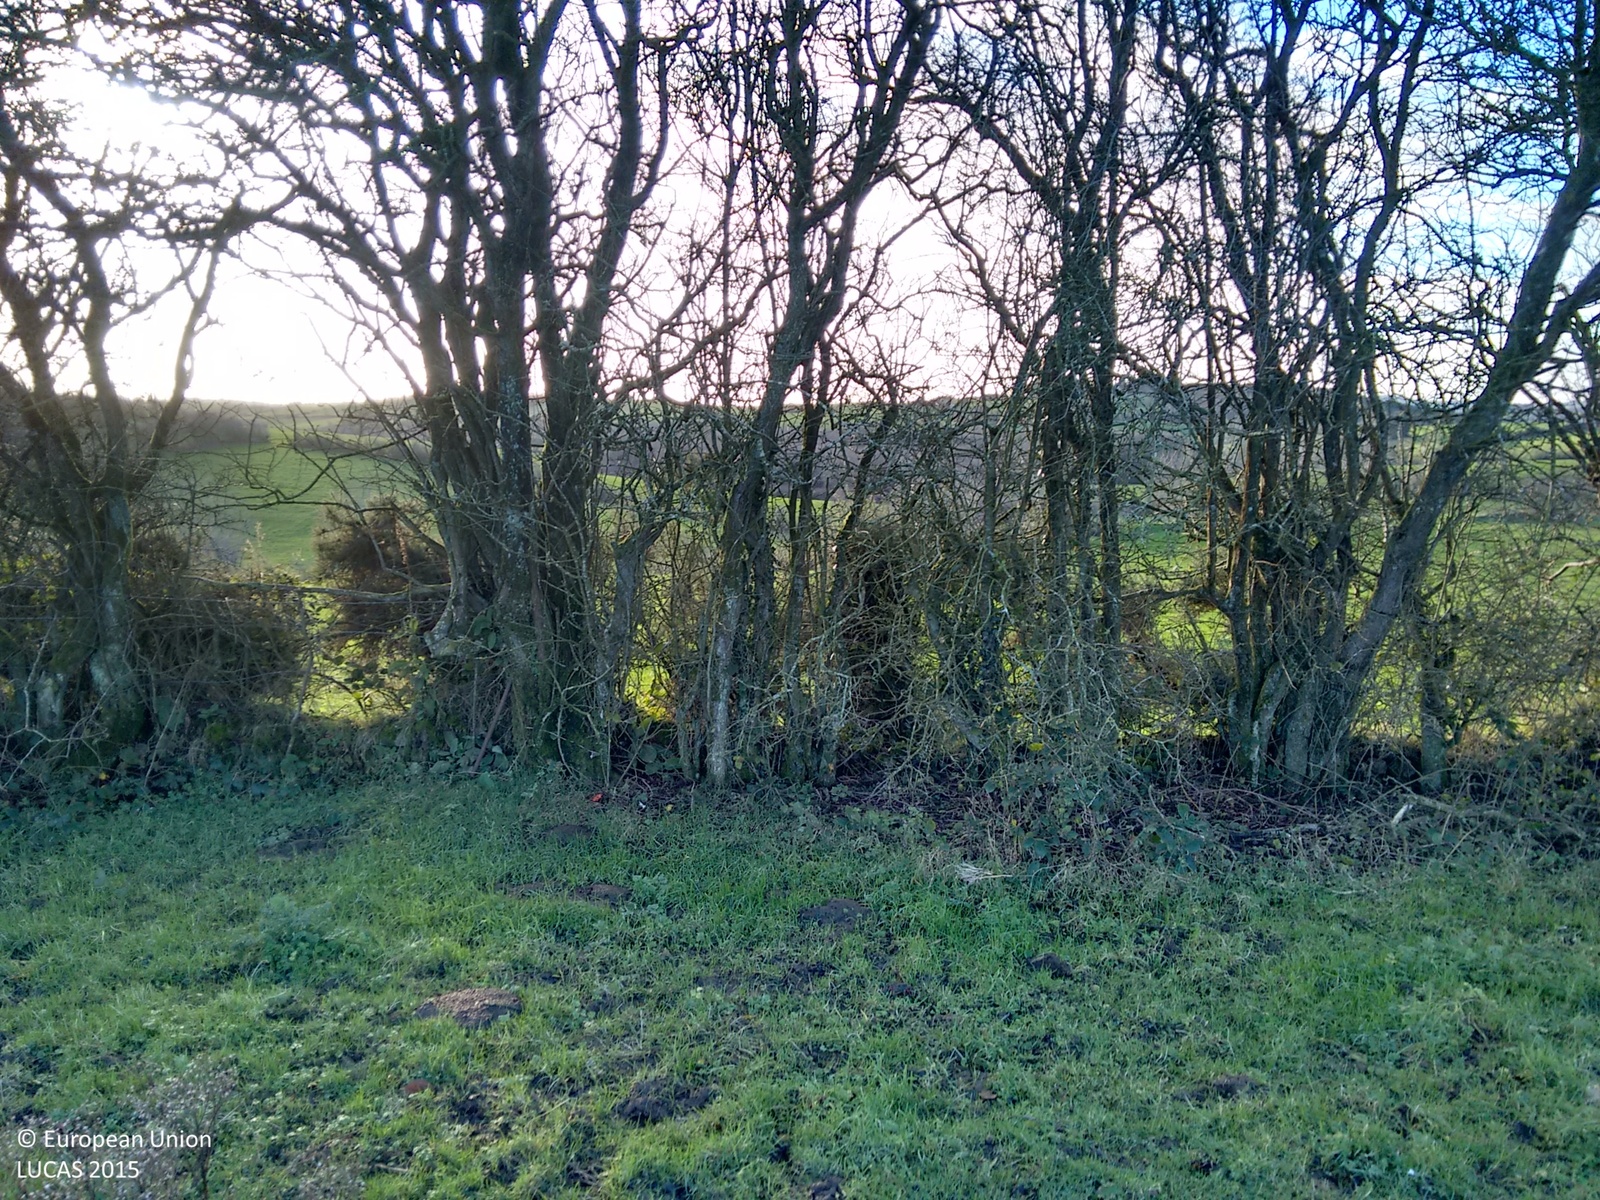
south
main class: Grassland
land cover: Grassland without tree/shrub cover
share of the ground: > 75 %
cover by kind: herbaceous plants 100 %
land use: Agriculture (excluding fallow land and kitchen gardens)
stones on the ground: < 10 %
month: December
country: IE
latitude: 53.9773
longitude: -6.8315
